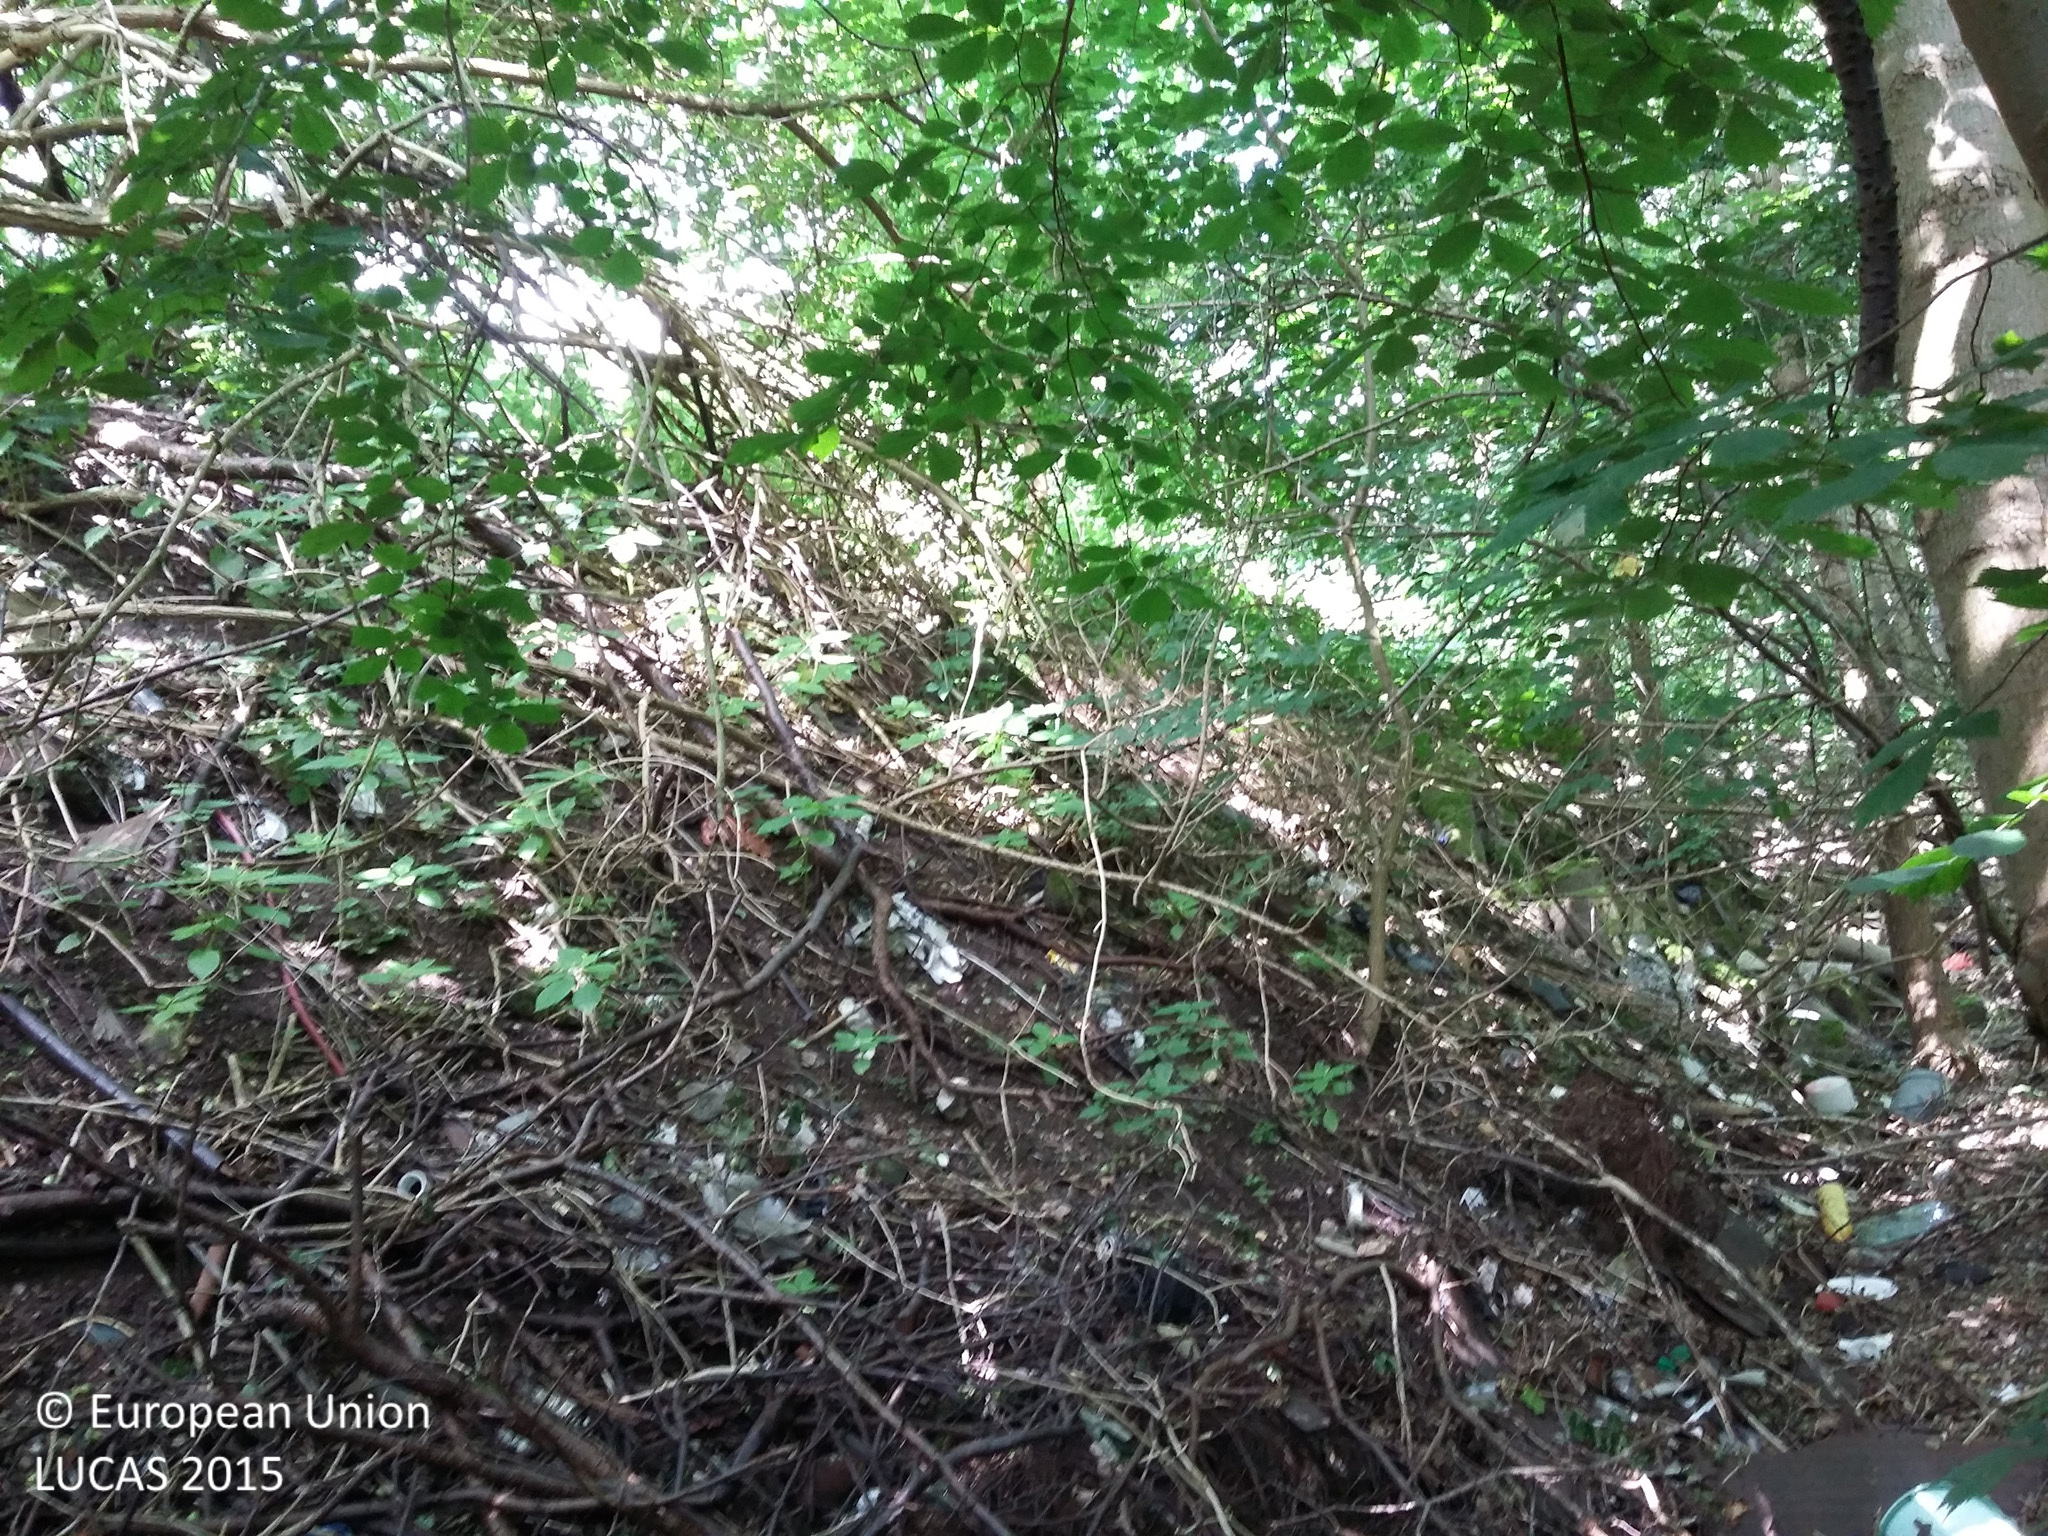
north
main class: Woodland
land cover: Broadleaved woodland
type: beech forest
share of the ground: > 75 %
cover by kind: broadleaved forest trees 80 %, herbaceous plants 15 %, shrubs 5 %
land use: Semi-natural and natural areas not in use
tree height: > 5 m
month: July
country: DK
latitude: 55.4954
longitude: 11.5341
